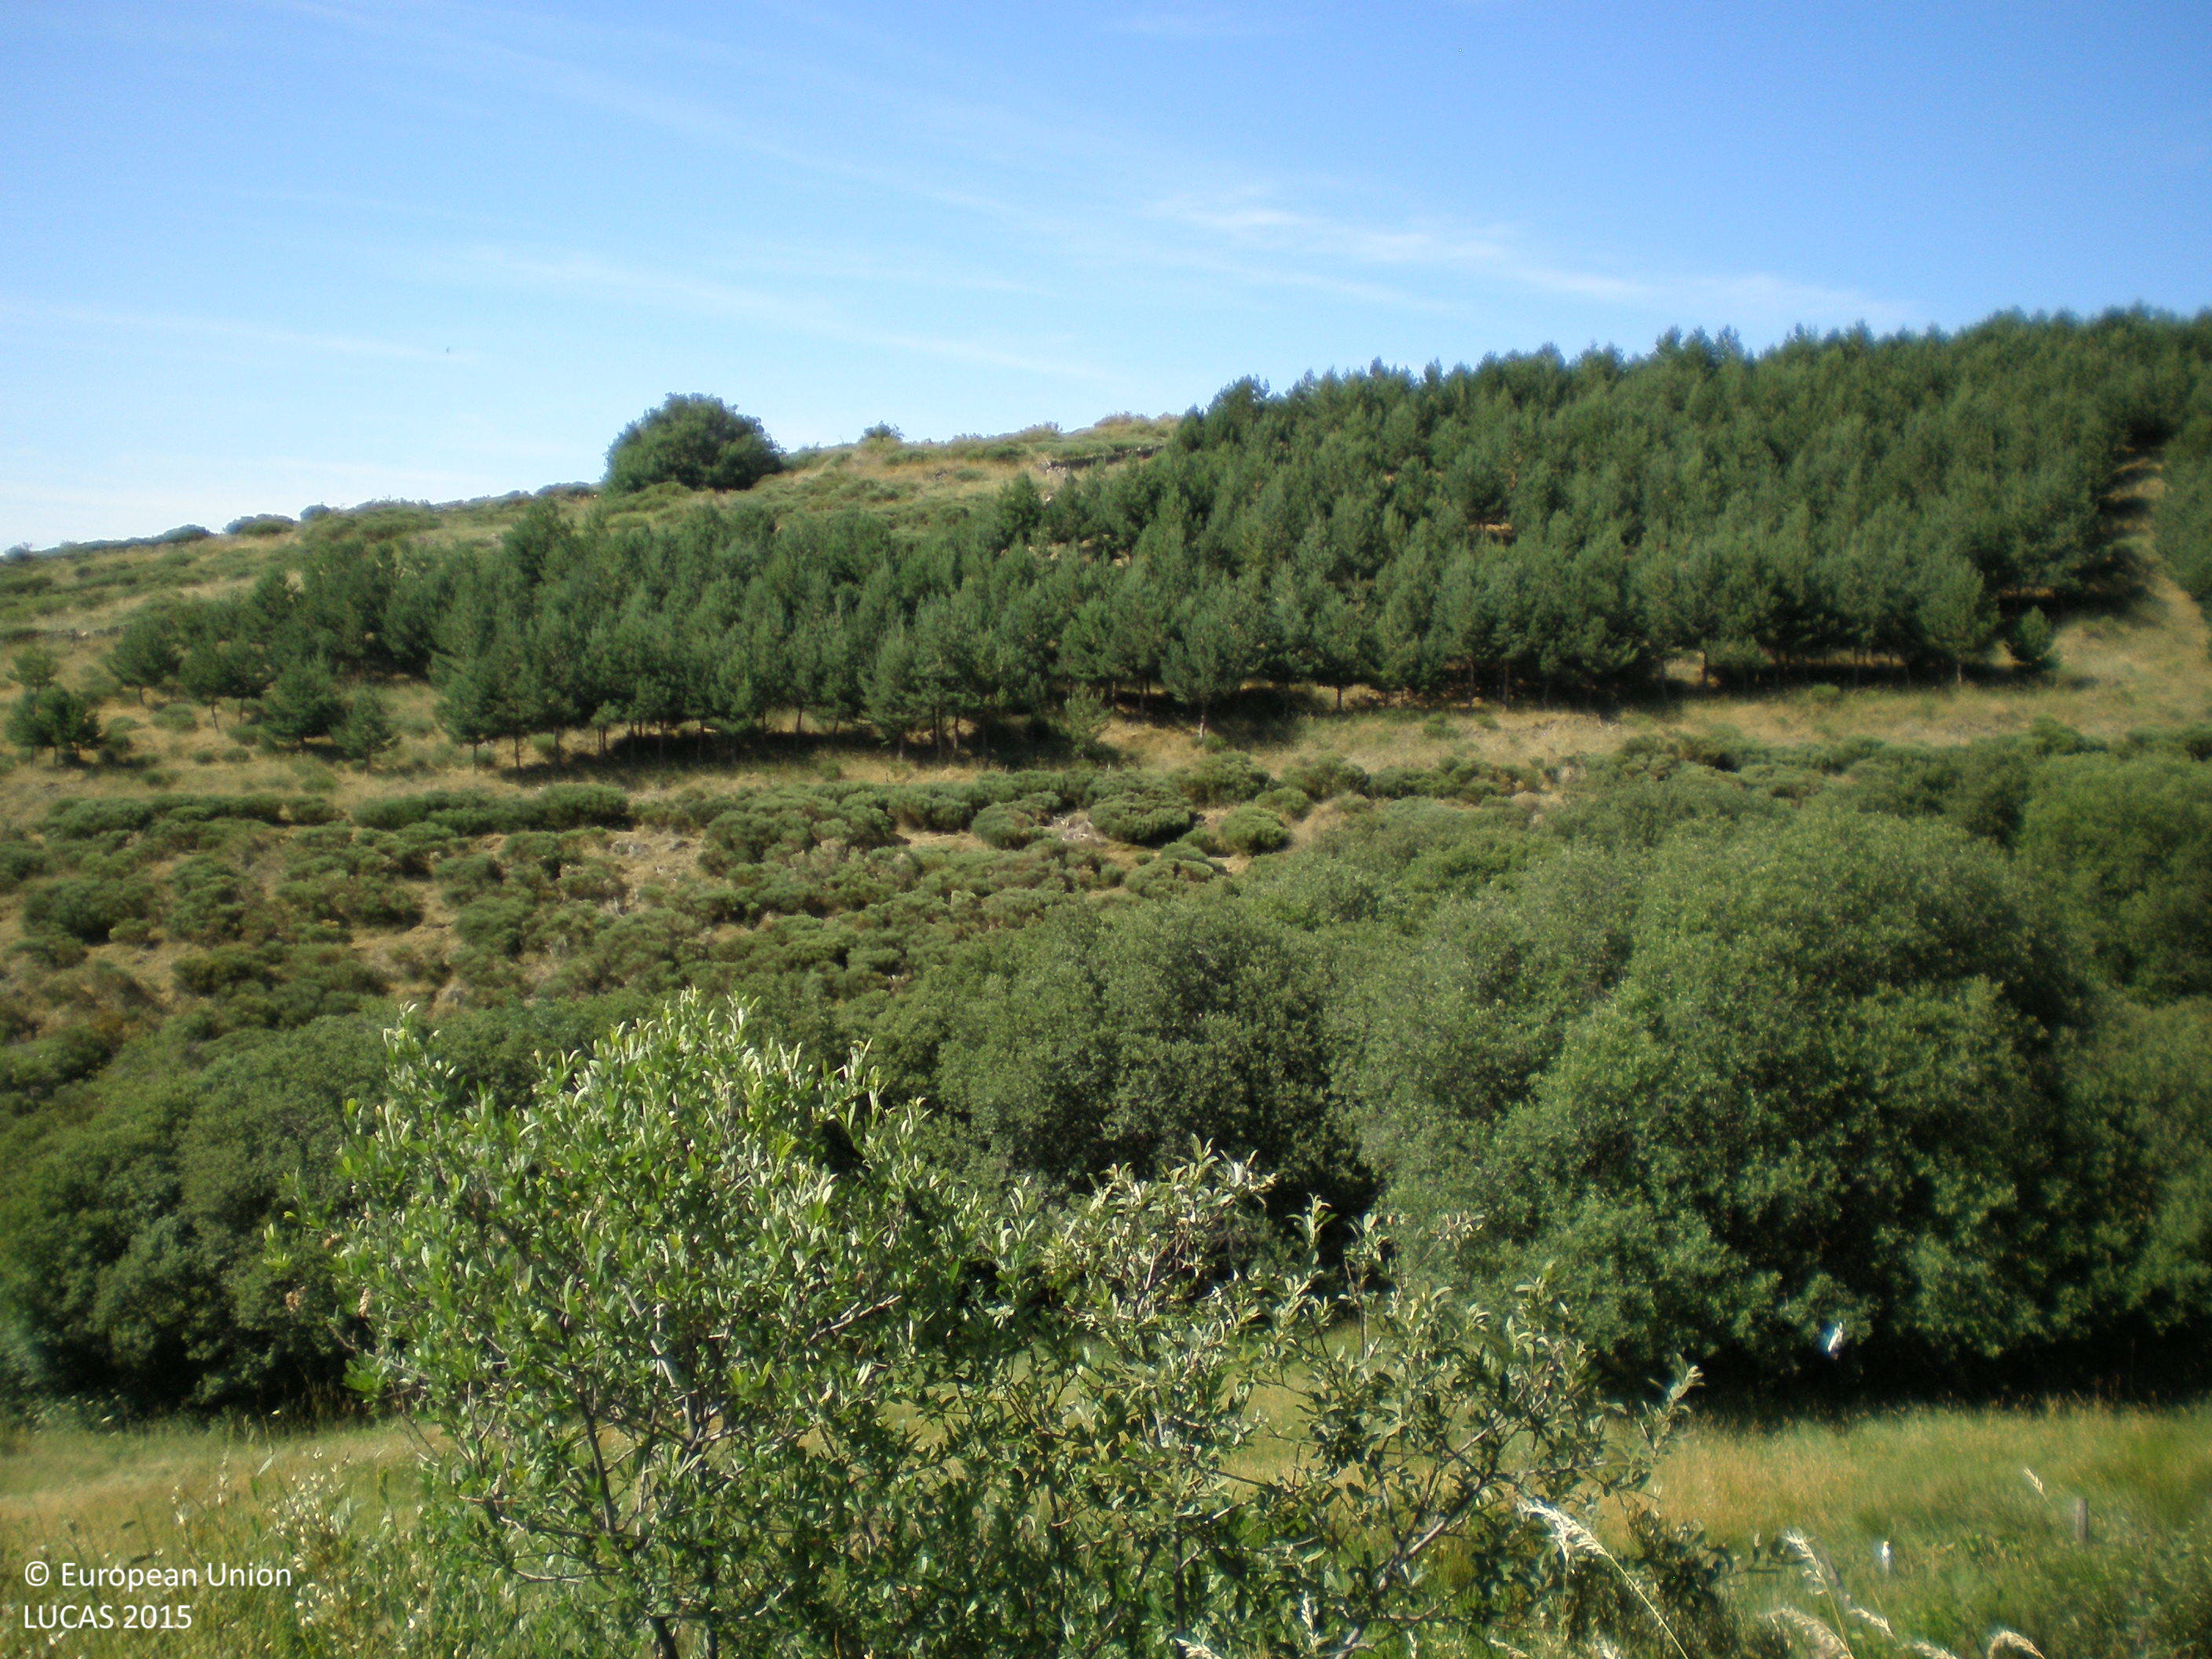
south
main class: Shrubland
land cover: Shrubland without tree cover
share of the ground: > 75 %
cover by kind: shrubs 80 %, herbaceous plants 20 %
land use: Abandoned areas
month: July
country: ES
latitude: 40.4368
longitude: -5.1856
